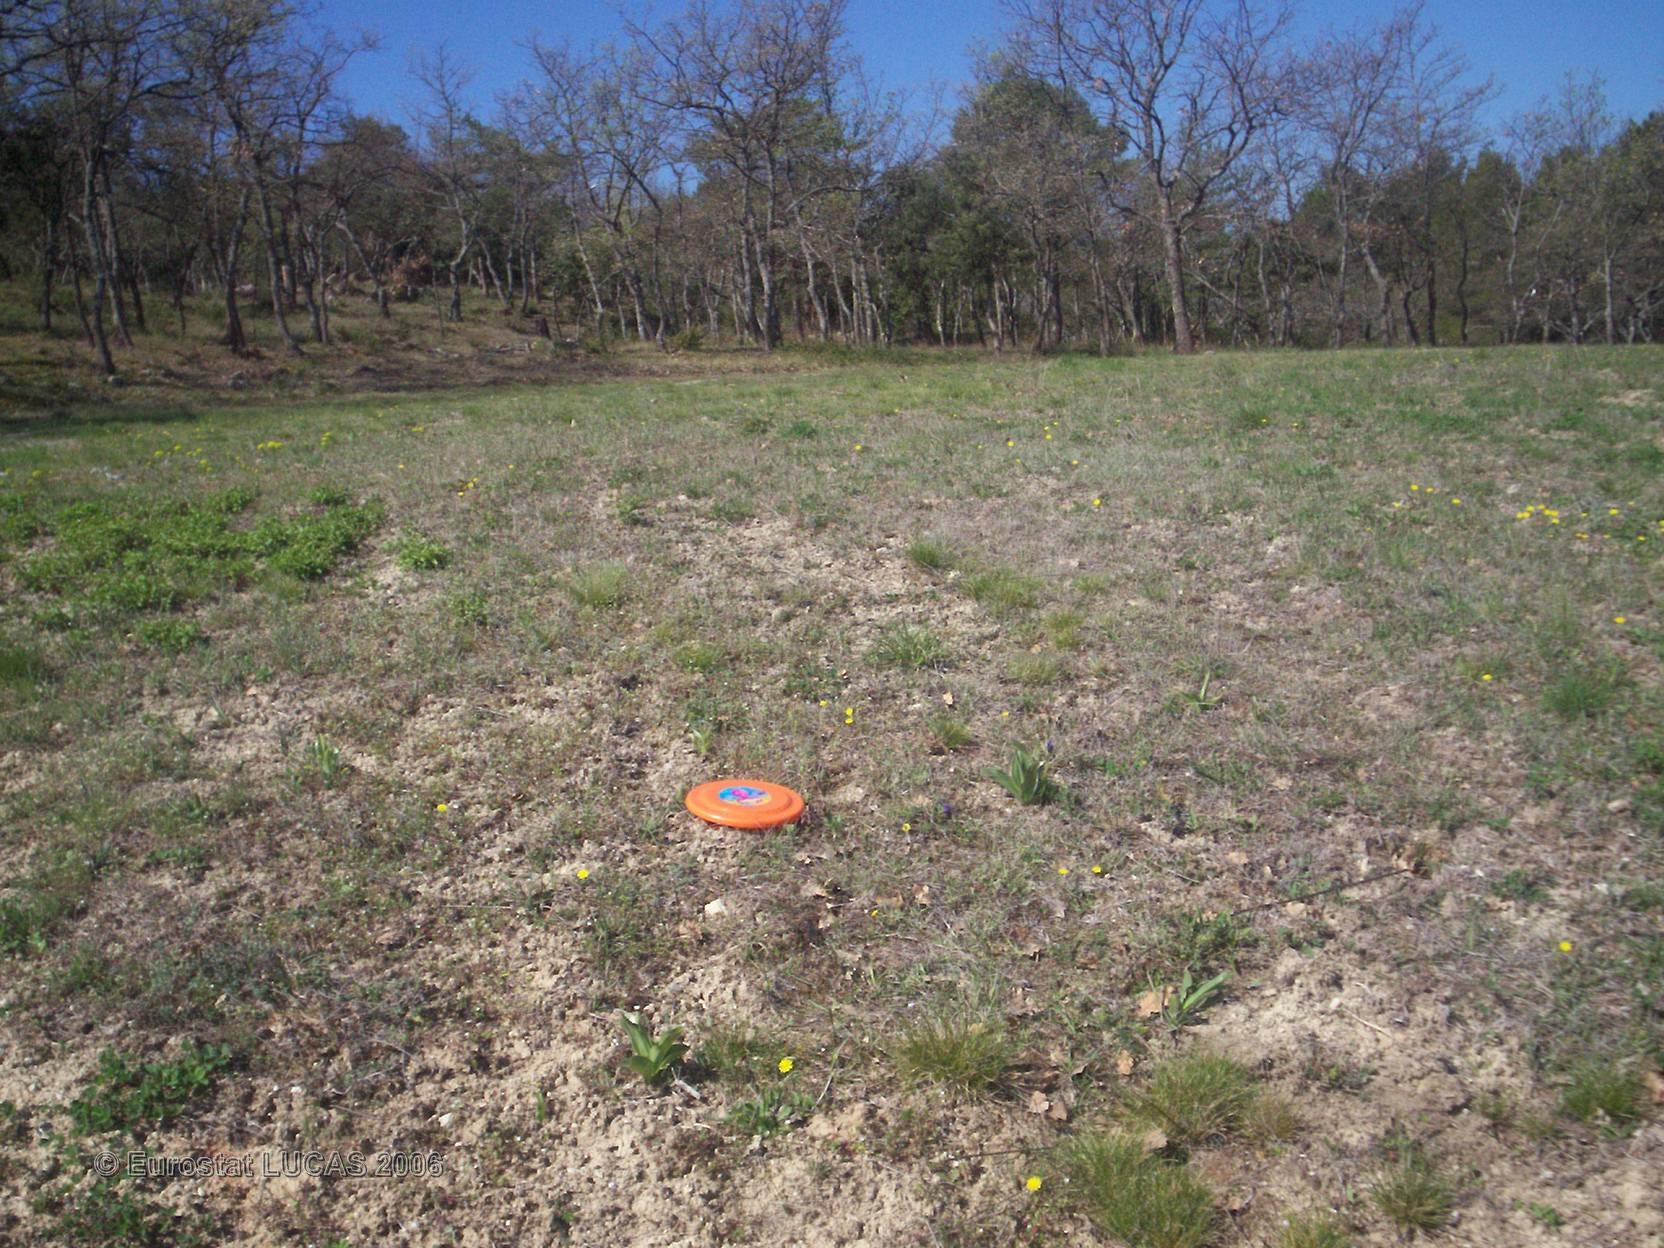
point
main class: Grassland
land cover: Grassland without tree/shrub cover
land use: Agriculture (excluding fallow land and kitchen gardens)
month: April
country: FR
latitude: 43.8452
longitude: 5.2697
